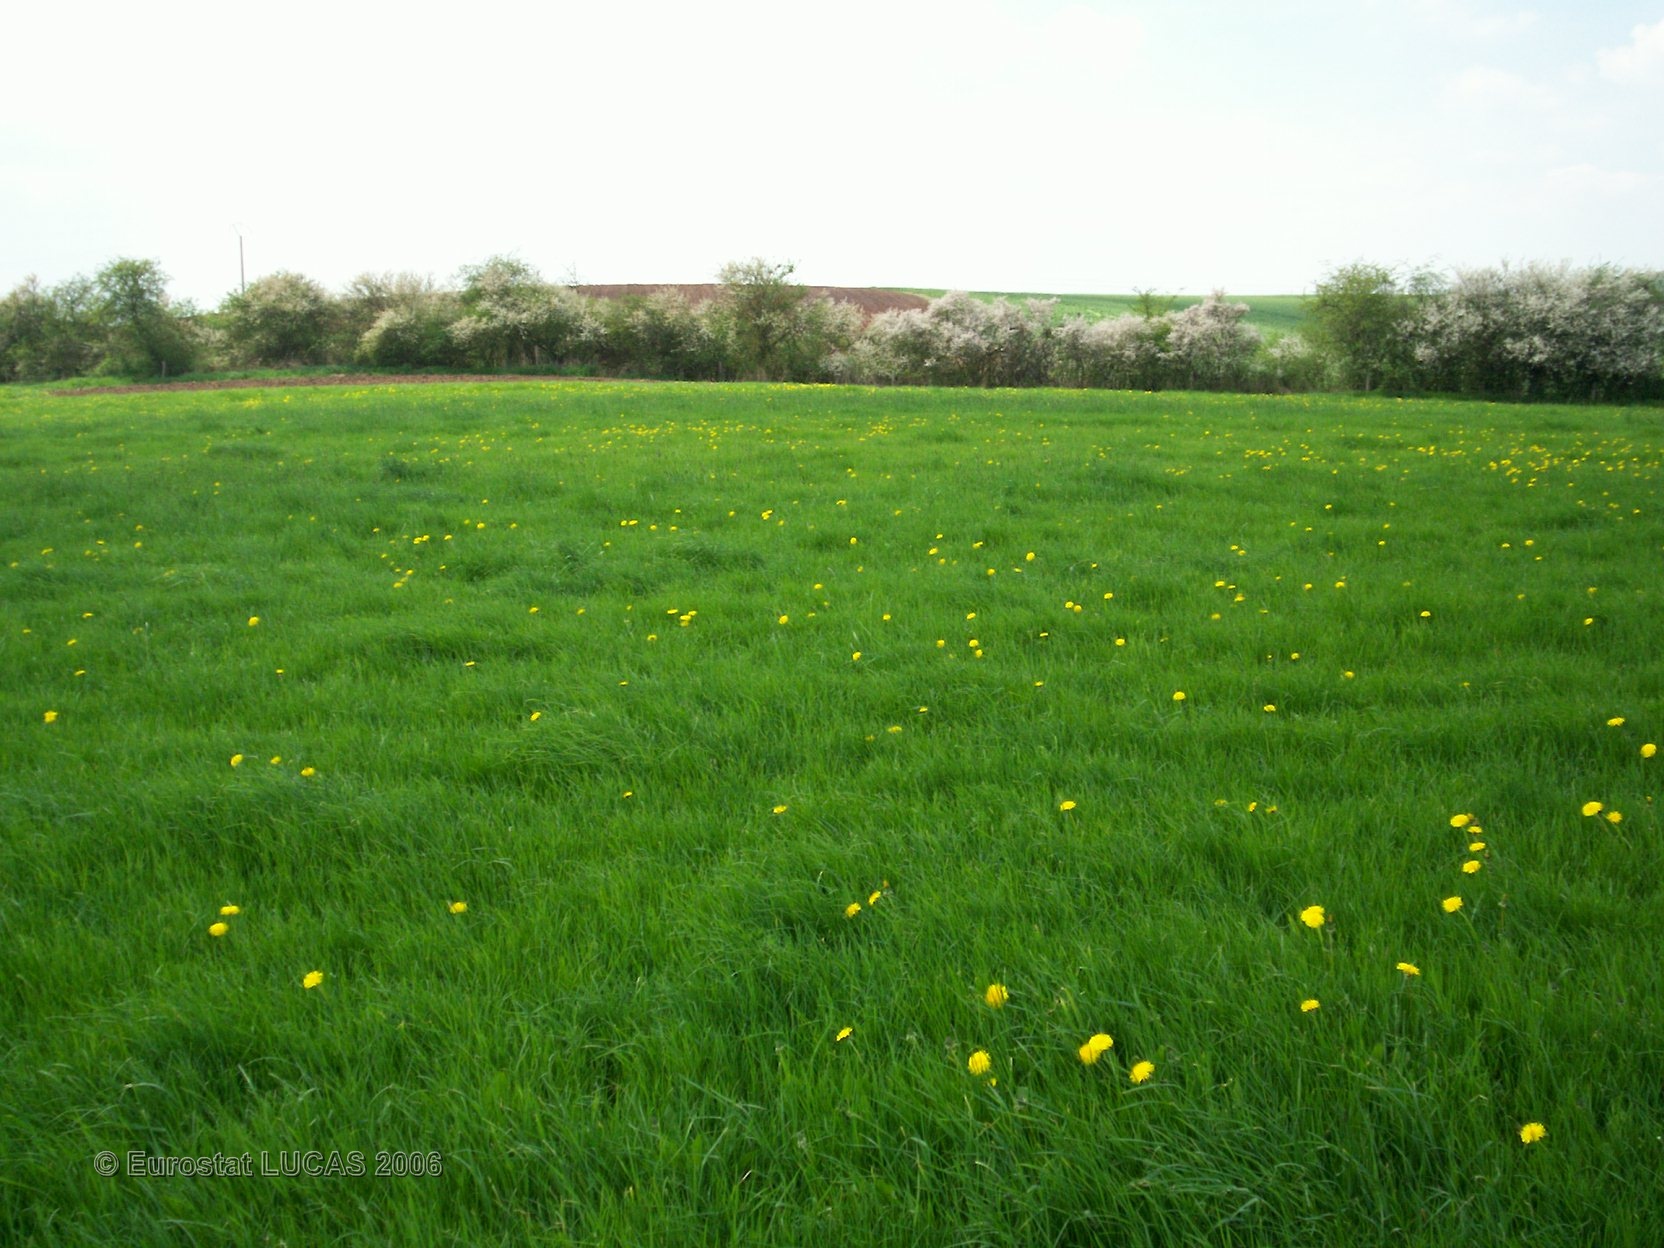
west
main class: Grassland
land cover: Grassland without tree/shrub cover
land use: Agriculture (excluding fallow land and kitchen gardens)
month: April
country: FR
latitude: 48.9675
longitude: 6.7356
